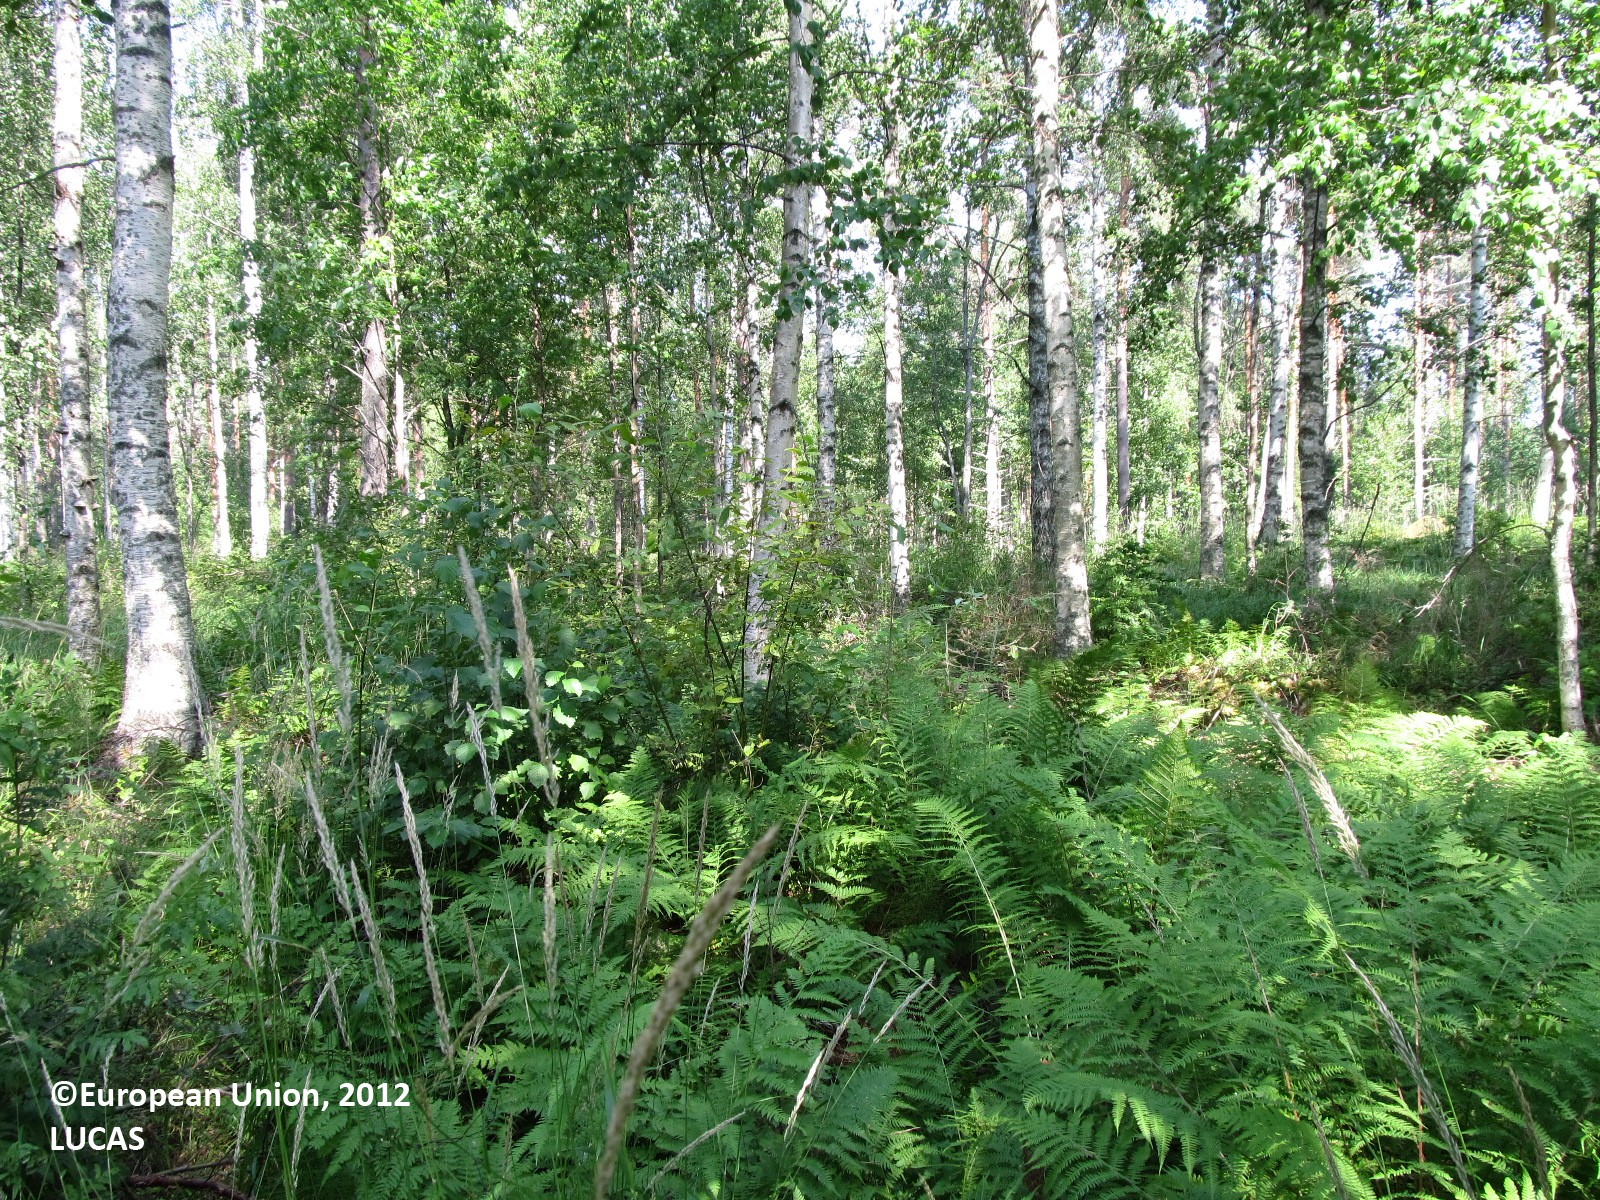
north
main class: Woodland
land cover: Pine dominated mixed woodland
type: boreal forest
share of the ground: 25 - 50 %
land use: Forestry
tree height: > 5 m
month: August
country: FI
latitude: 62.0943
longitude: 28.6955
